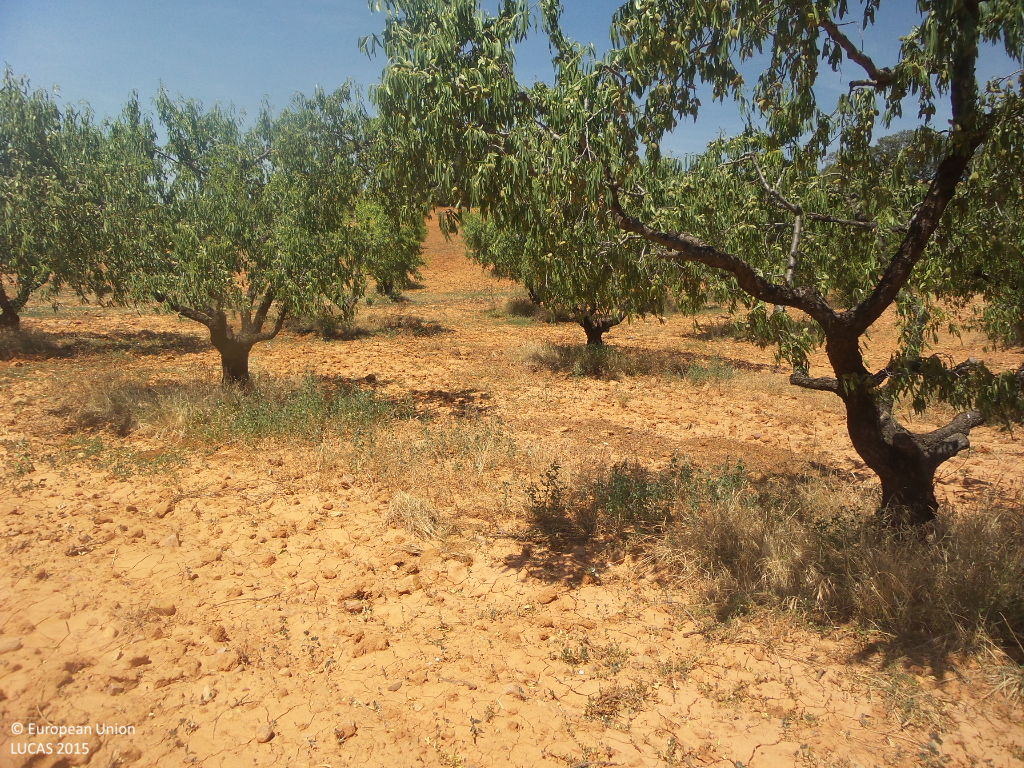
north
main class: Cropland
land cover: Nuts trees
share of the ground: 25 - 50 %
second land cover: Other bare soil
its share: > 75 %
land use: Agriculture (excluding fallow land and kitchen gardens)
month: July
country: ES
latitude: 41.2151
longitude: -1.9421
